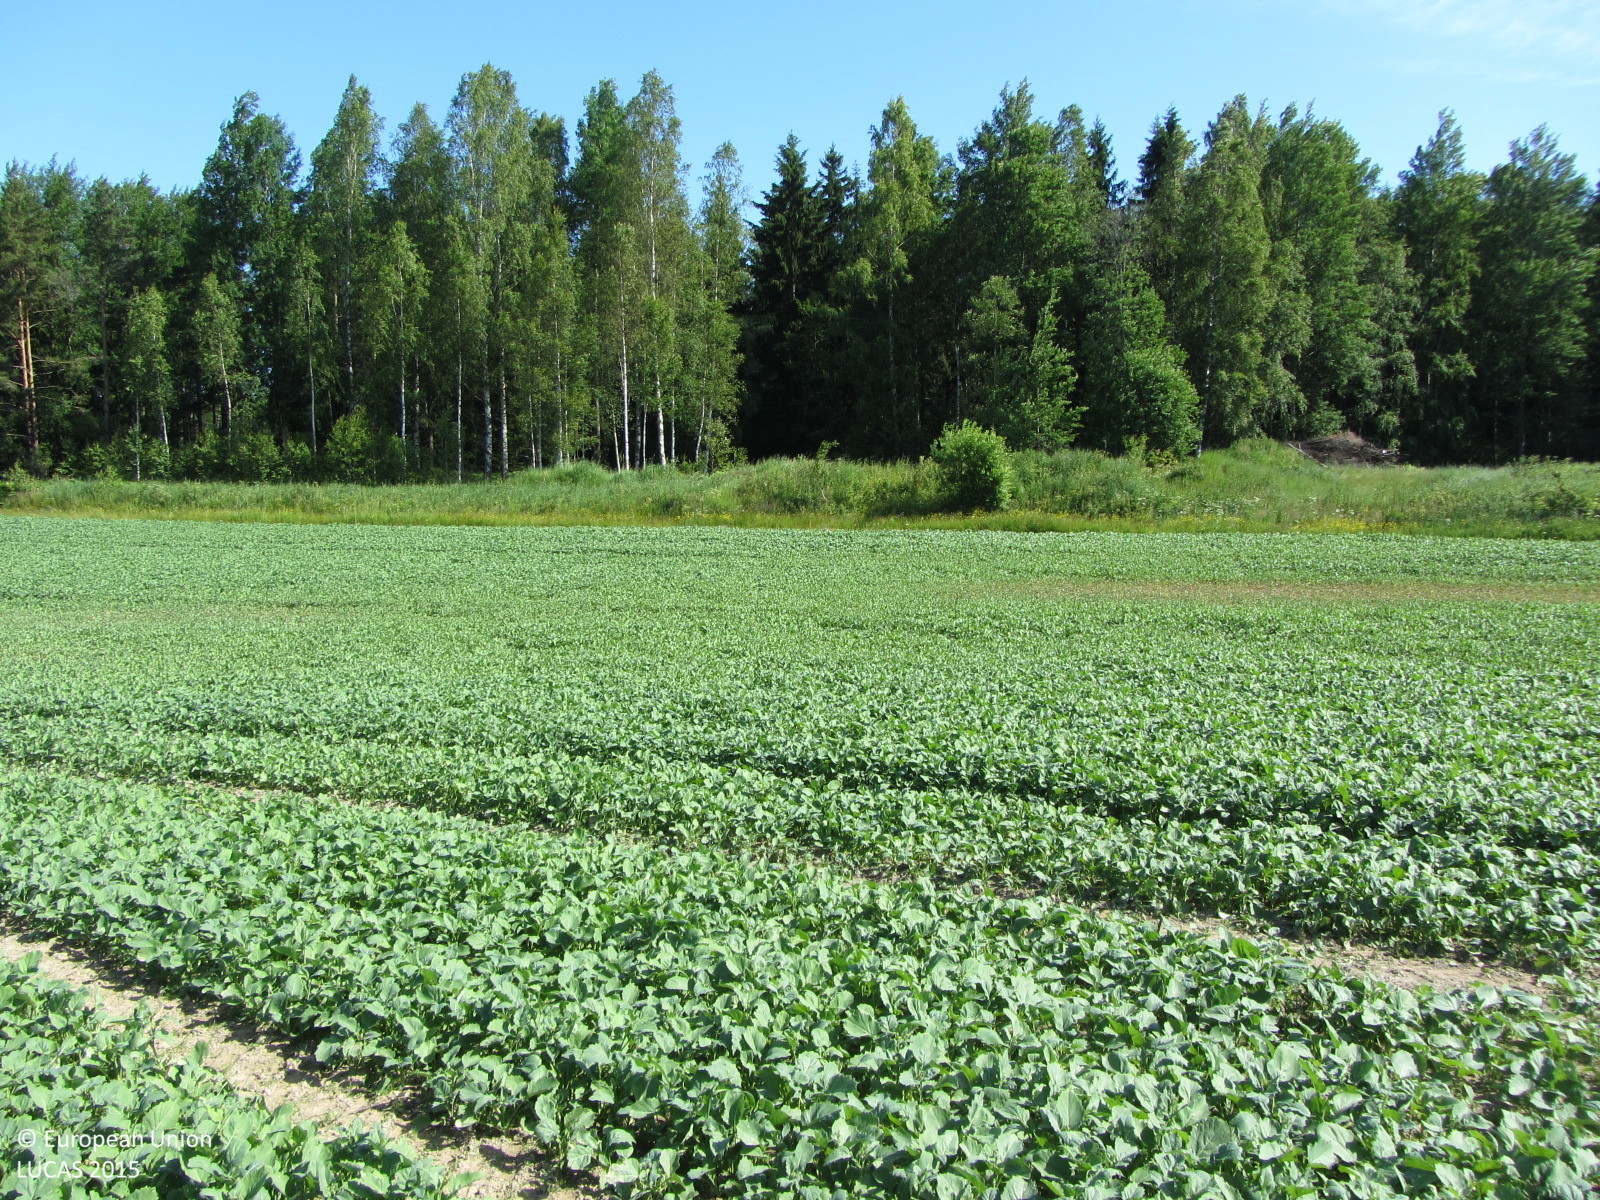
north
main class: Cropland
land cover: Other root crops
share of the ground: > 75 %
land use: Agriculture (excluding fallow land and kitchen gardens)
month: July
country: FI
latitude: 60.0889
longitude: 23.3732
